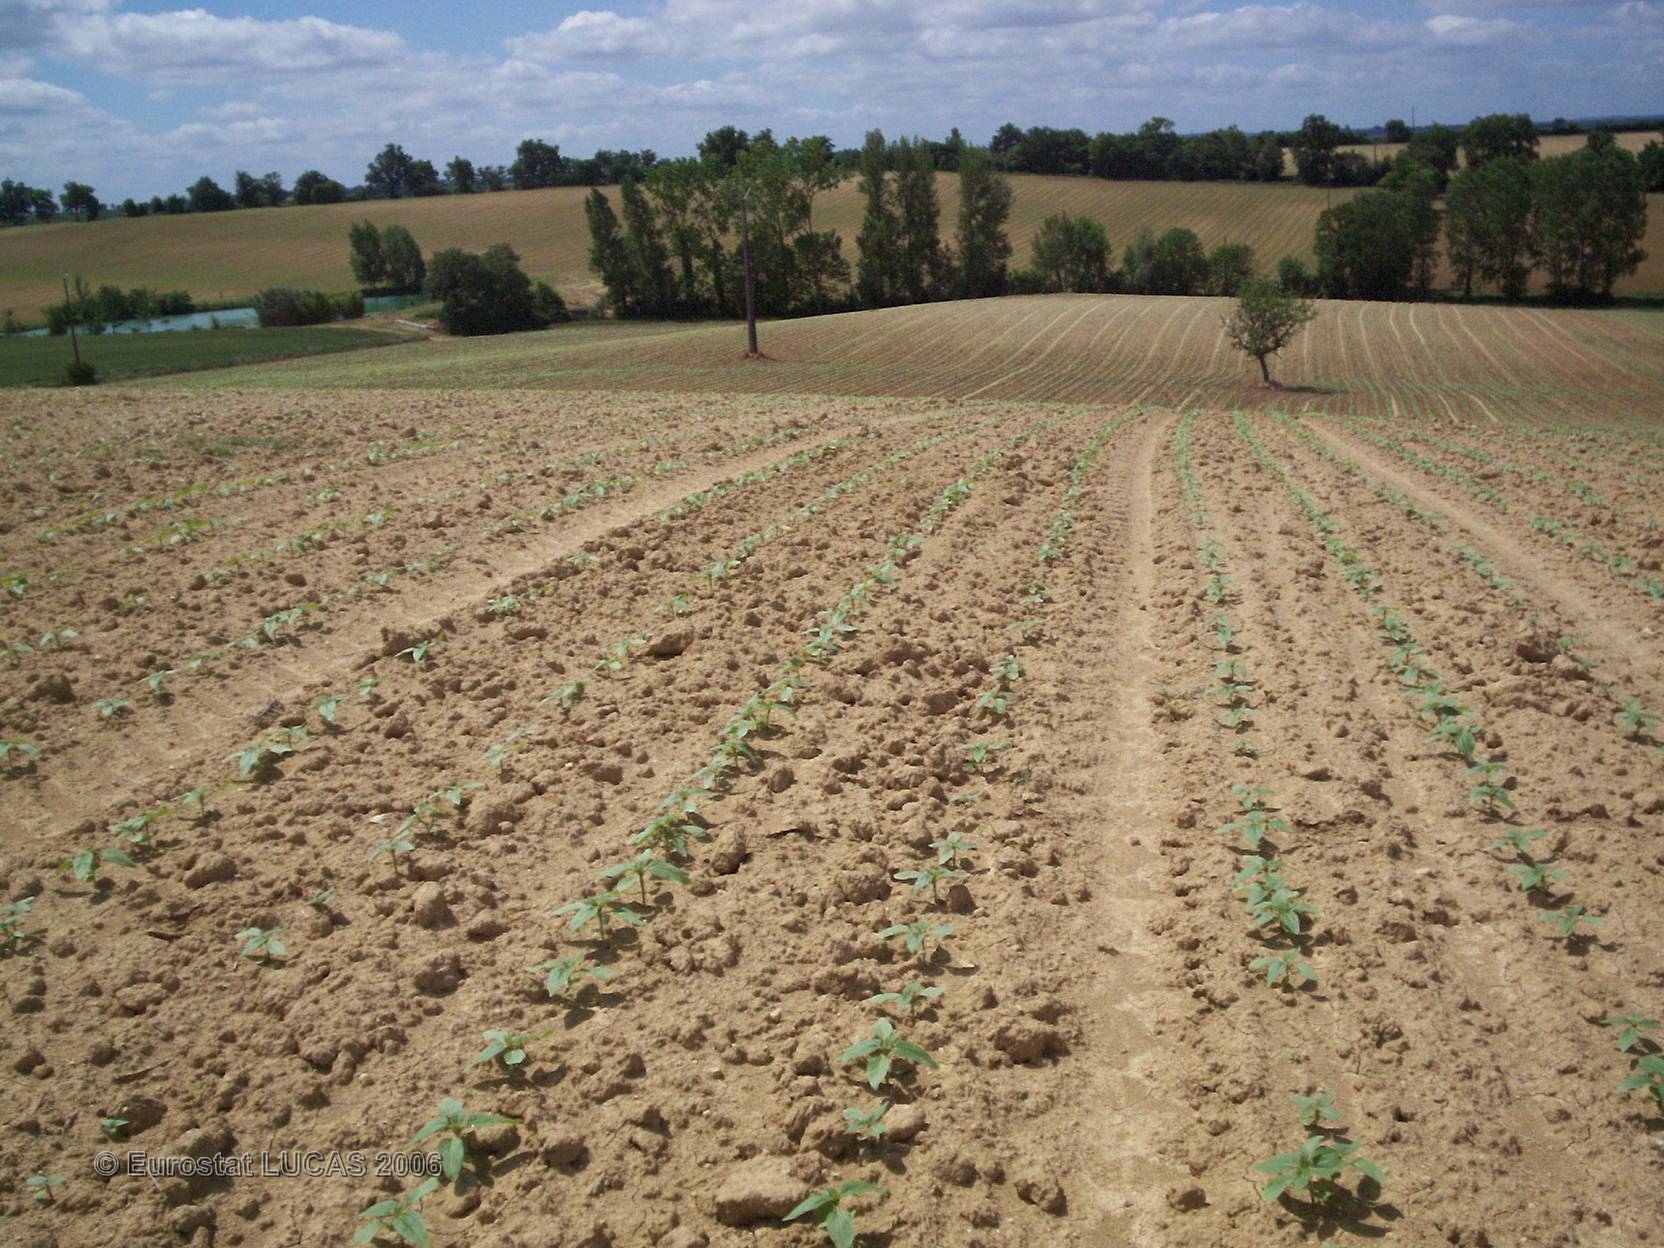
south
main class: Cropland
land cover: Soya
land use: Agriculture (excluding fallow land and kitchen gardens)
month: May
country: FR
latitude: 43.6650
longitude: 0.9592
